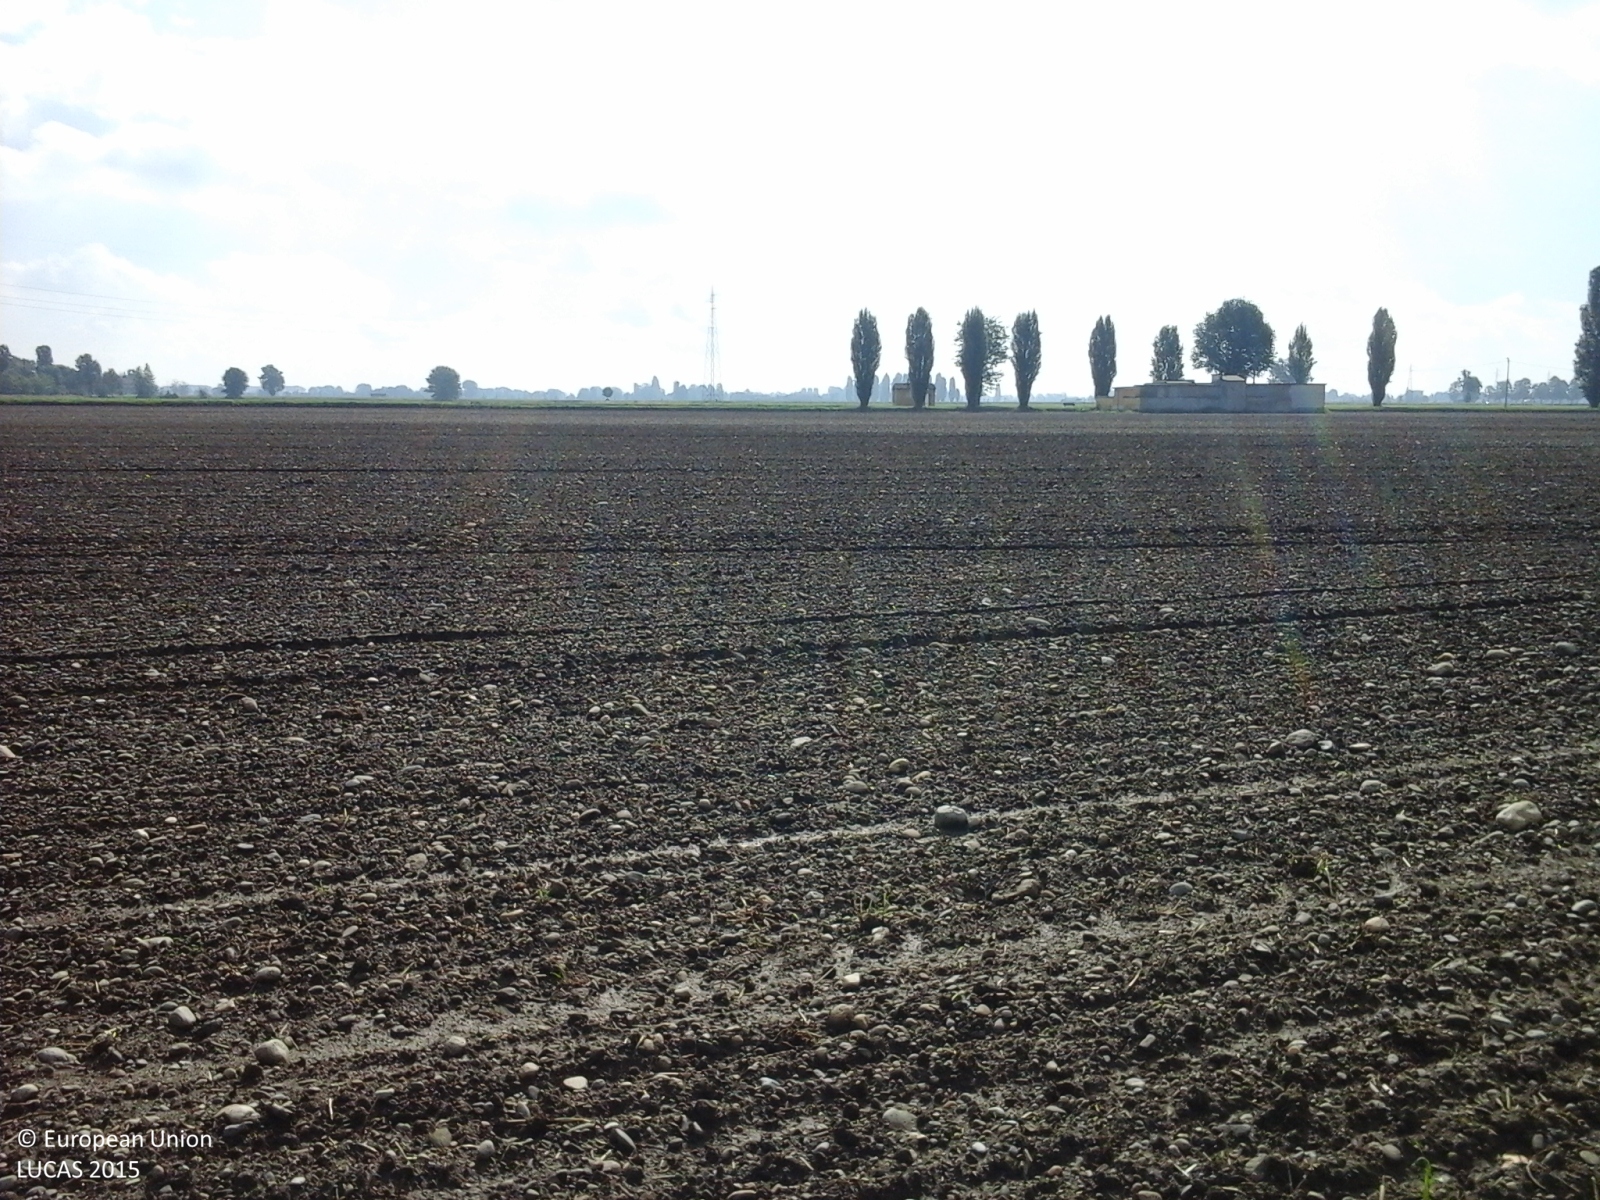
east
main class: Grassland
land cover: Grassland with sparse tree/shrub cover
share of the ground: > 75 %
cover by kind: herbaceous plants 85 %, shrubs 10 %, broadleaved forest trees 5 %
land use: Agriculture (excluding fallow land and kitchen gardens)
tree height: > 5 m
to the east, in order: Grassland with sparse tree/shrub cover; Other bare soil; Grass margins; Ditches and canals; Grass margins; Tracks
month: May
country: IT
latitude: 45.4312
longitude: 9.5279
